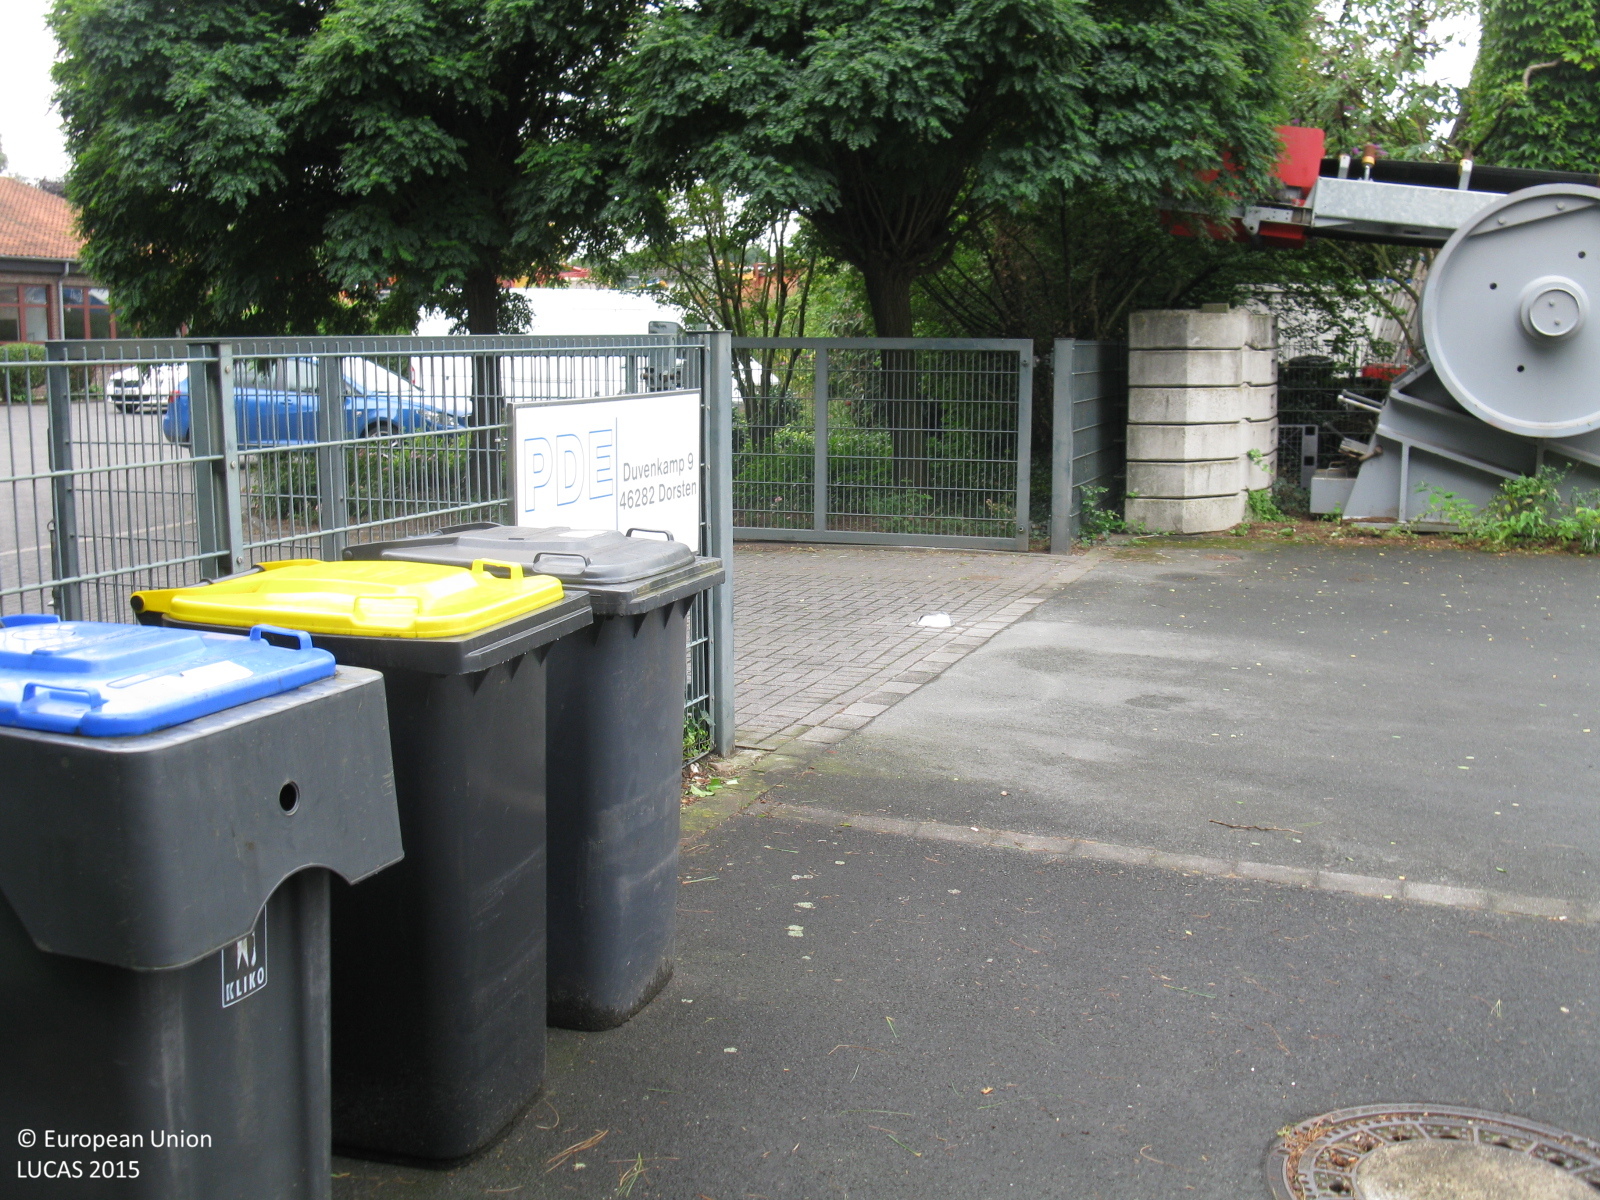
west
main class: Woodland
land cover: Broadleaved woodland
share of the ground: 50 - 75 %
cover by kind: broadleaved forest trees 70 %, herbaceous plants 30 %
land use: Residential
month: August
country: DE
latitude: 51.6548
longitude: 6.9501
